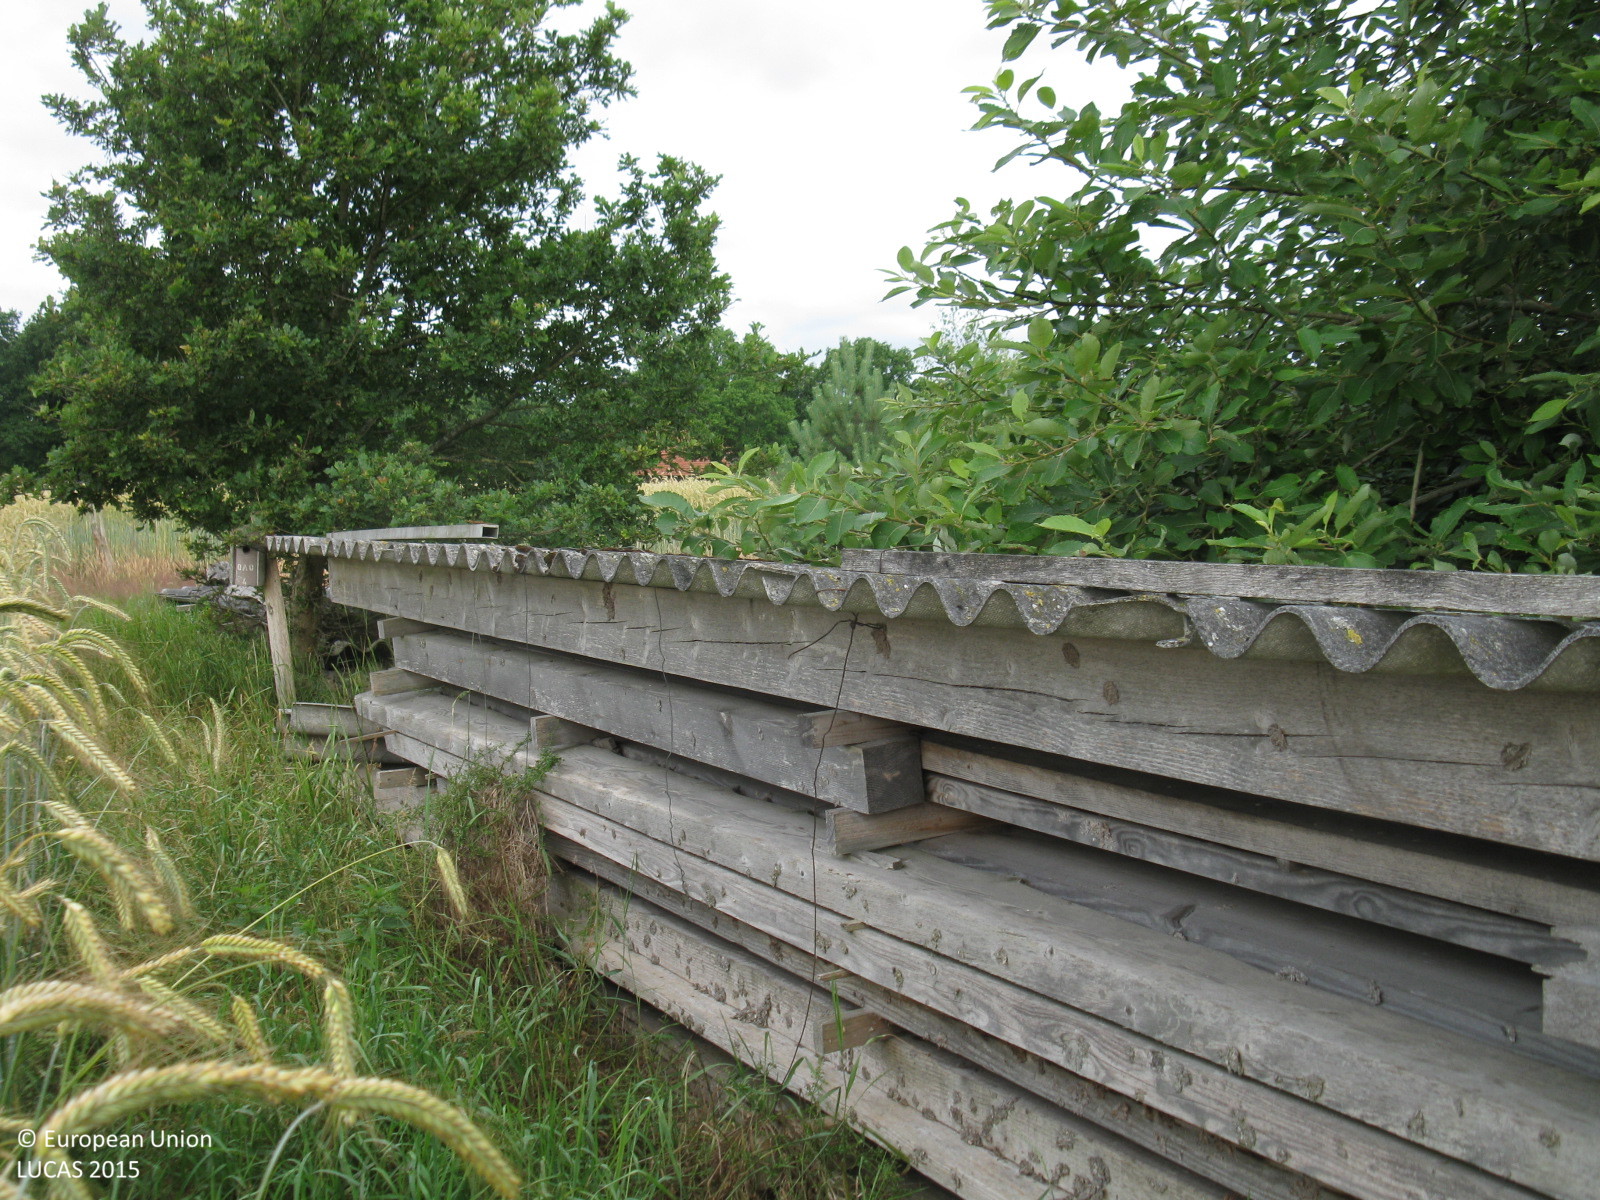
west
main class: Cropland
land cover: Rye
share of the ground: > 75 %
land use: Agriculture (excluding fallow land and kitchen gardens)
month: July
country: DE
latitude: 53.3490
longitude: 7.9727
